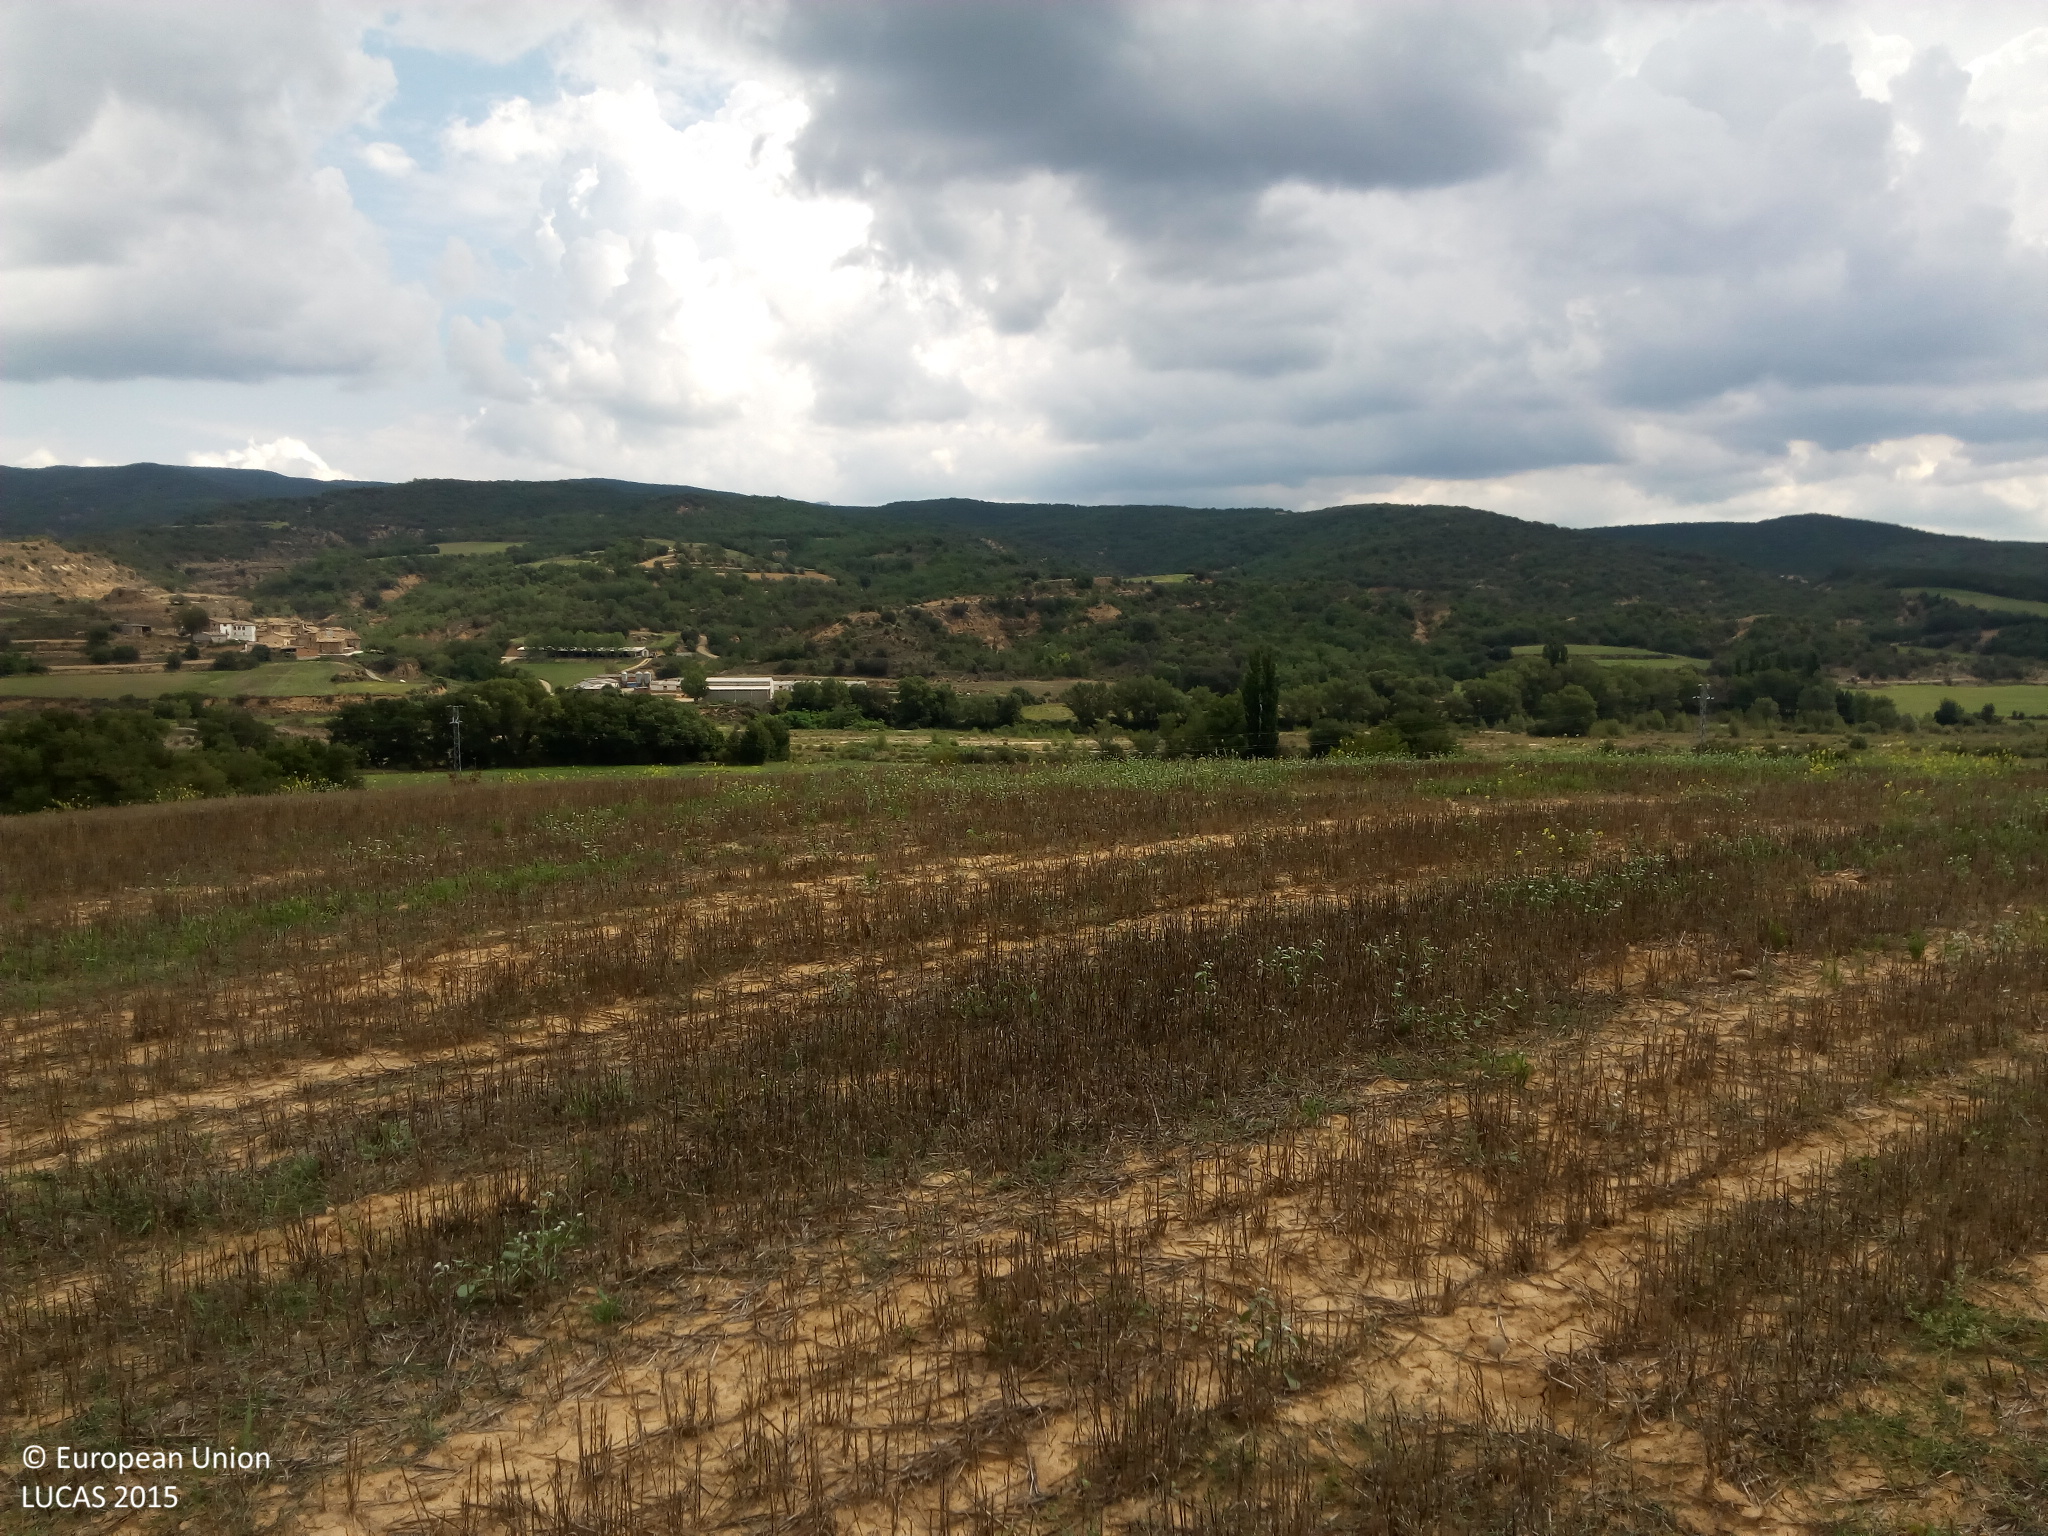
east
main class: Grassland
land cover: Spontaneously vegetated surfaces
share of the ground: > 75 %
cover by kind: unconsolidated bare surface 60 %, herbaceous plants 40 %
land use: Fallow land
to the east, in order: Spontaneously vegetated surfaces; Grass margins; Spontaneously vegetated surfaces; Groves; Spontaneously vegetated surfaces; Electric lines; Spontaneously vegetated surfaces; Groves; Shruby margins; Tracks; Spontaneously vegetated surfaces
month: August
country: ES
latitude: 42.0655
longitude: 0.5453
